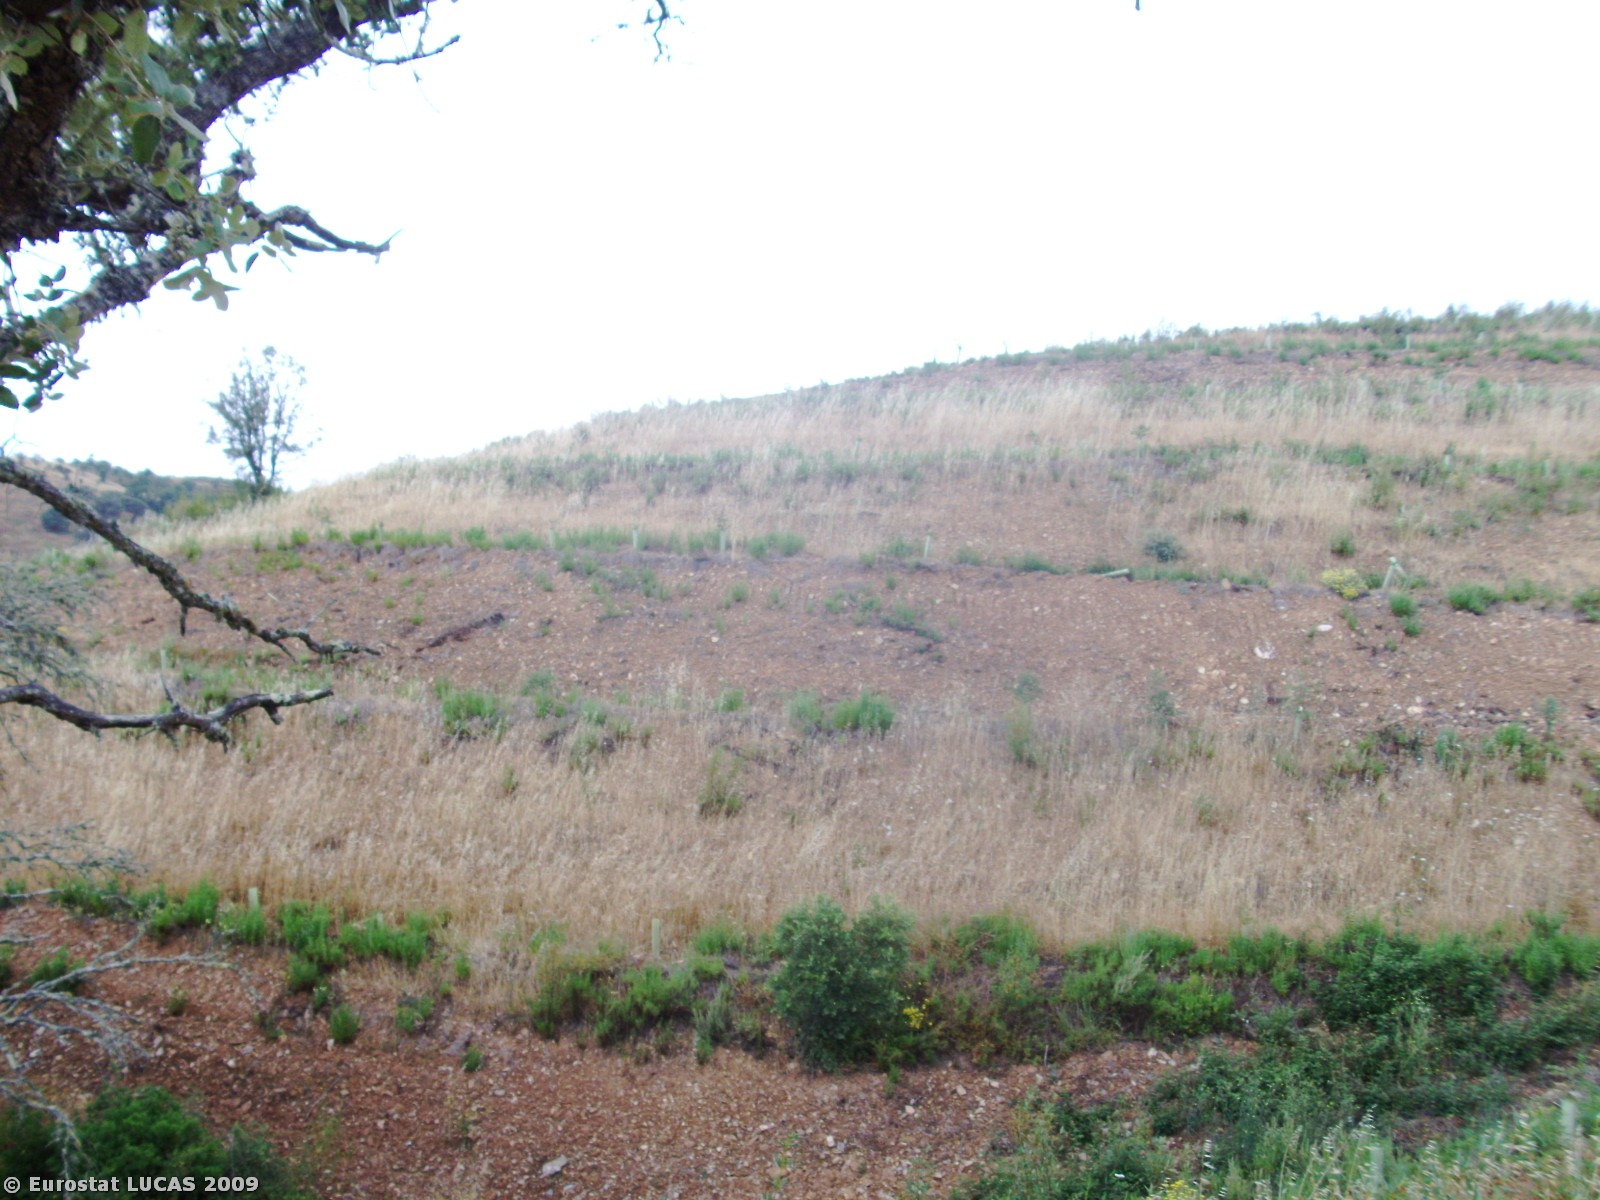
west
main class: Woodland
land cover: Broadleaved woodland
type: broadleaved evergreen forest
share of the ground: 10 - 25 %
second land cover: Spontaneously vegetated surfaces
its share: 50 - 75 %
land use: Forestry
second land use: Fallow land
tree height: > 5 m
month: June
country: PT
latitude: 37.4595
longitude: -8.4700
